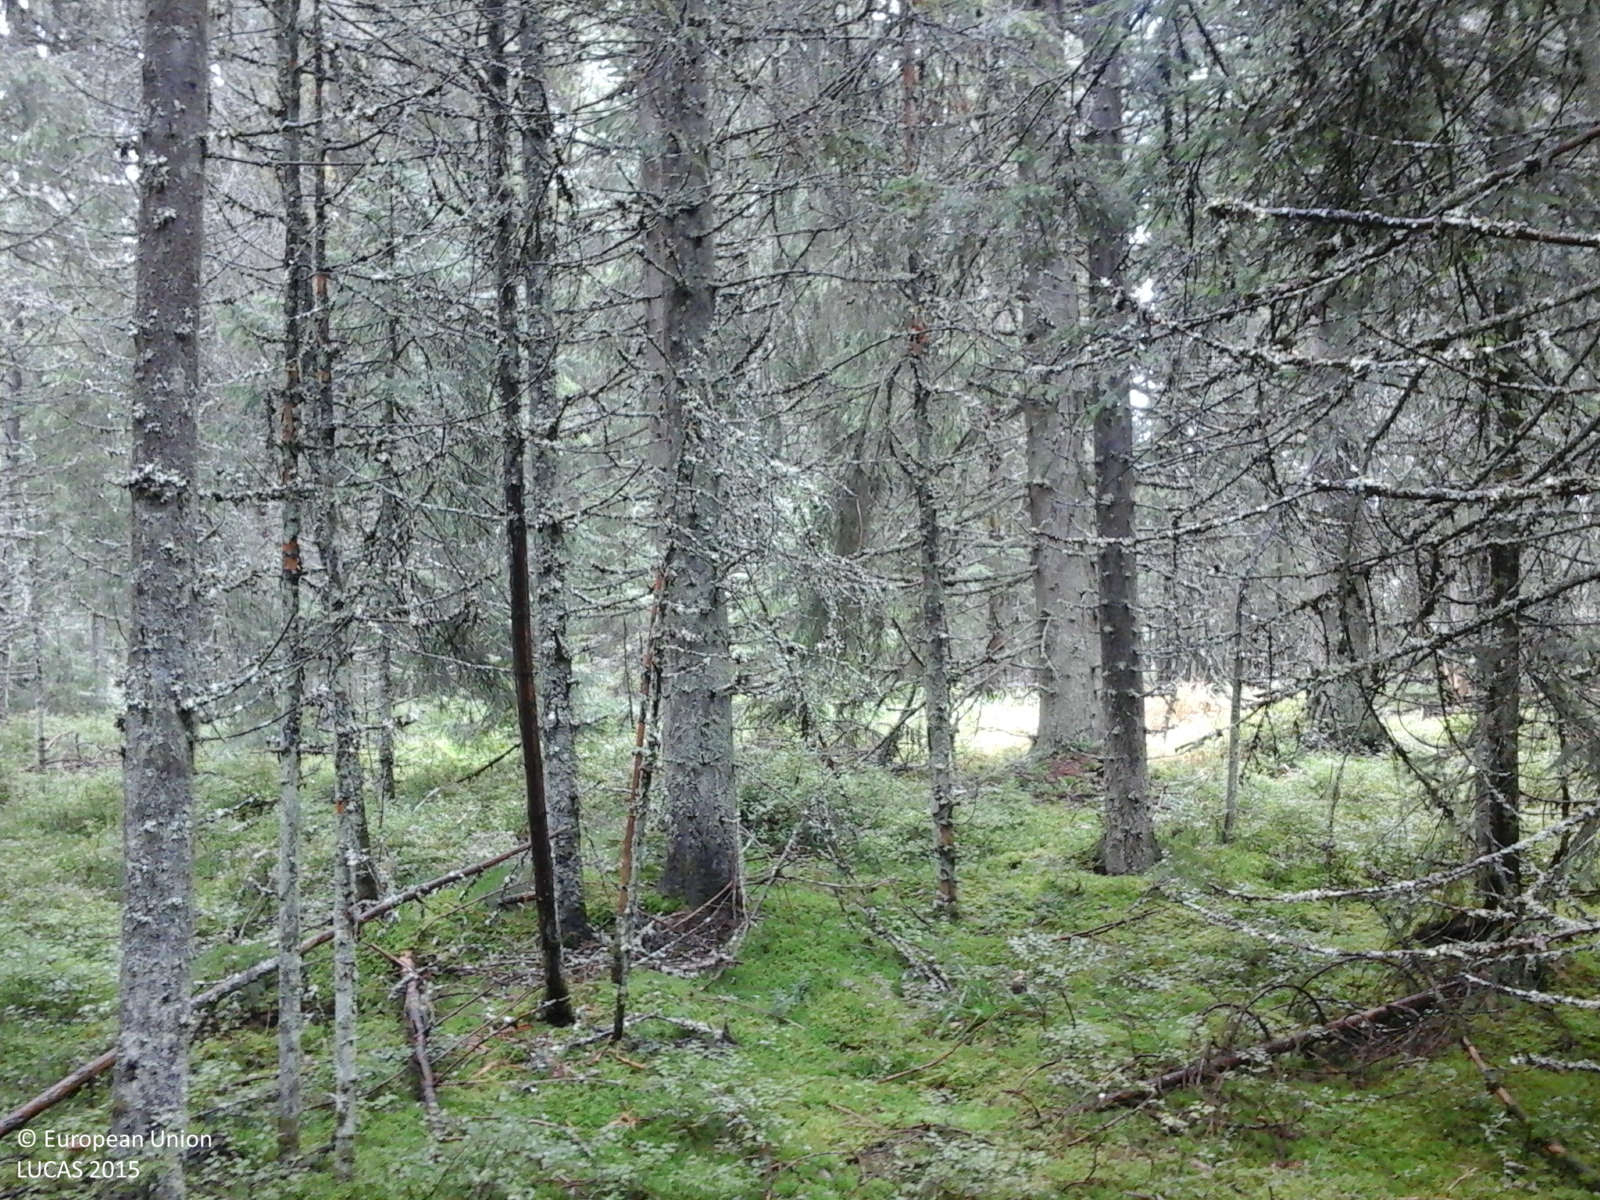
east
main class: Woodland
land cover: Spruce dominated coniferous woodland
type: alpine coniferous forest
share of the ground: > 75 %
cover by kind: coniferous forest trees 90 %, herbaceous plants 10 %
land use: Forestry
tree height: > 5 m
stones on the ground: 10 - 25 %
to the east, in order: Spruce dominated coniferous woodland; Tracks; Spruce dominated coniferous woodland
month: September
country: RO
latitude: 45.5924
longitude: 23.5607
